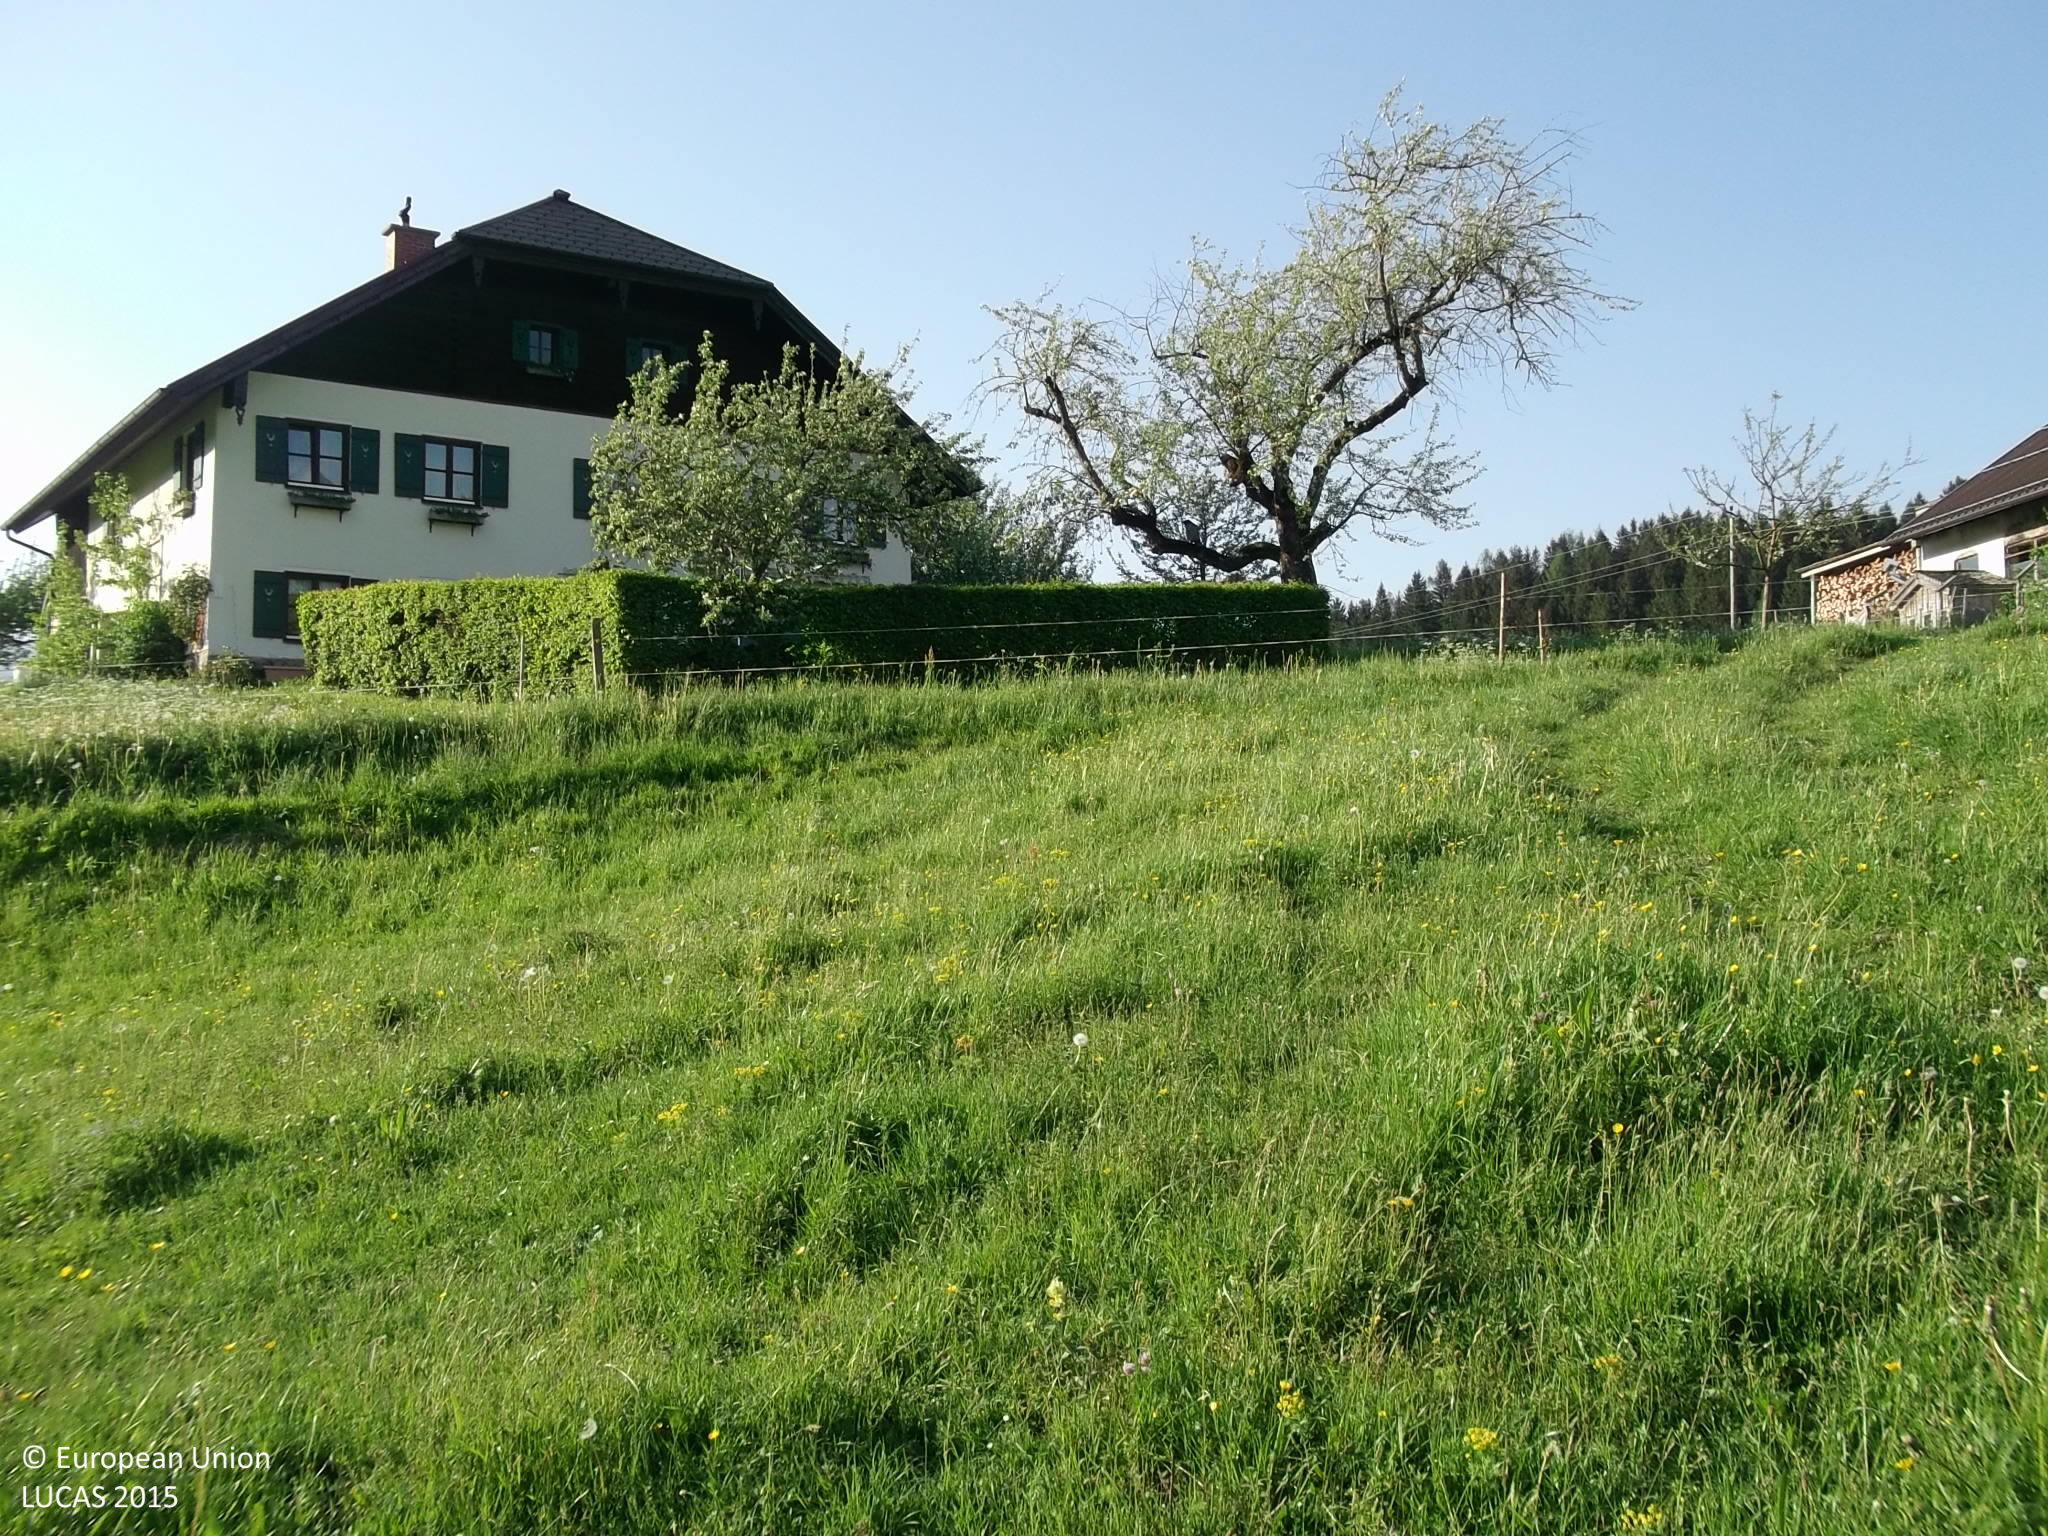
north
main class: Grassland
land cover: Grassland without tree/shrub cover
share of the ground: > 75 %
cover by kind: herbaceous plants 100 %
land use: Agriculture (excluding fallow land and kitchen gardens)
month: May
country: AT
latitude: 47.5607
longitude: 13.3343
